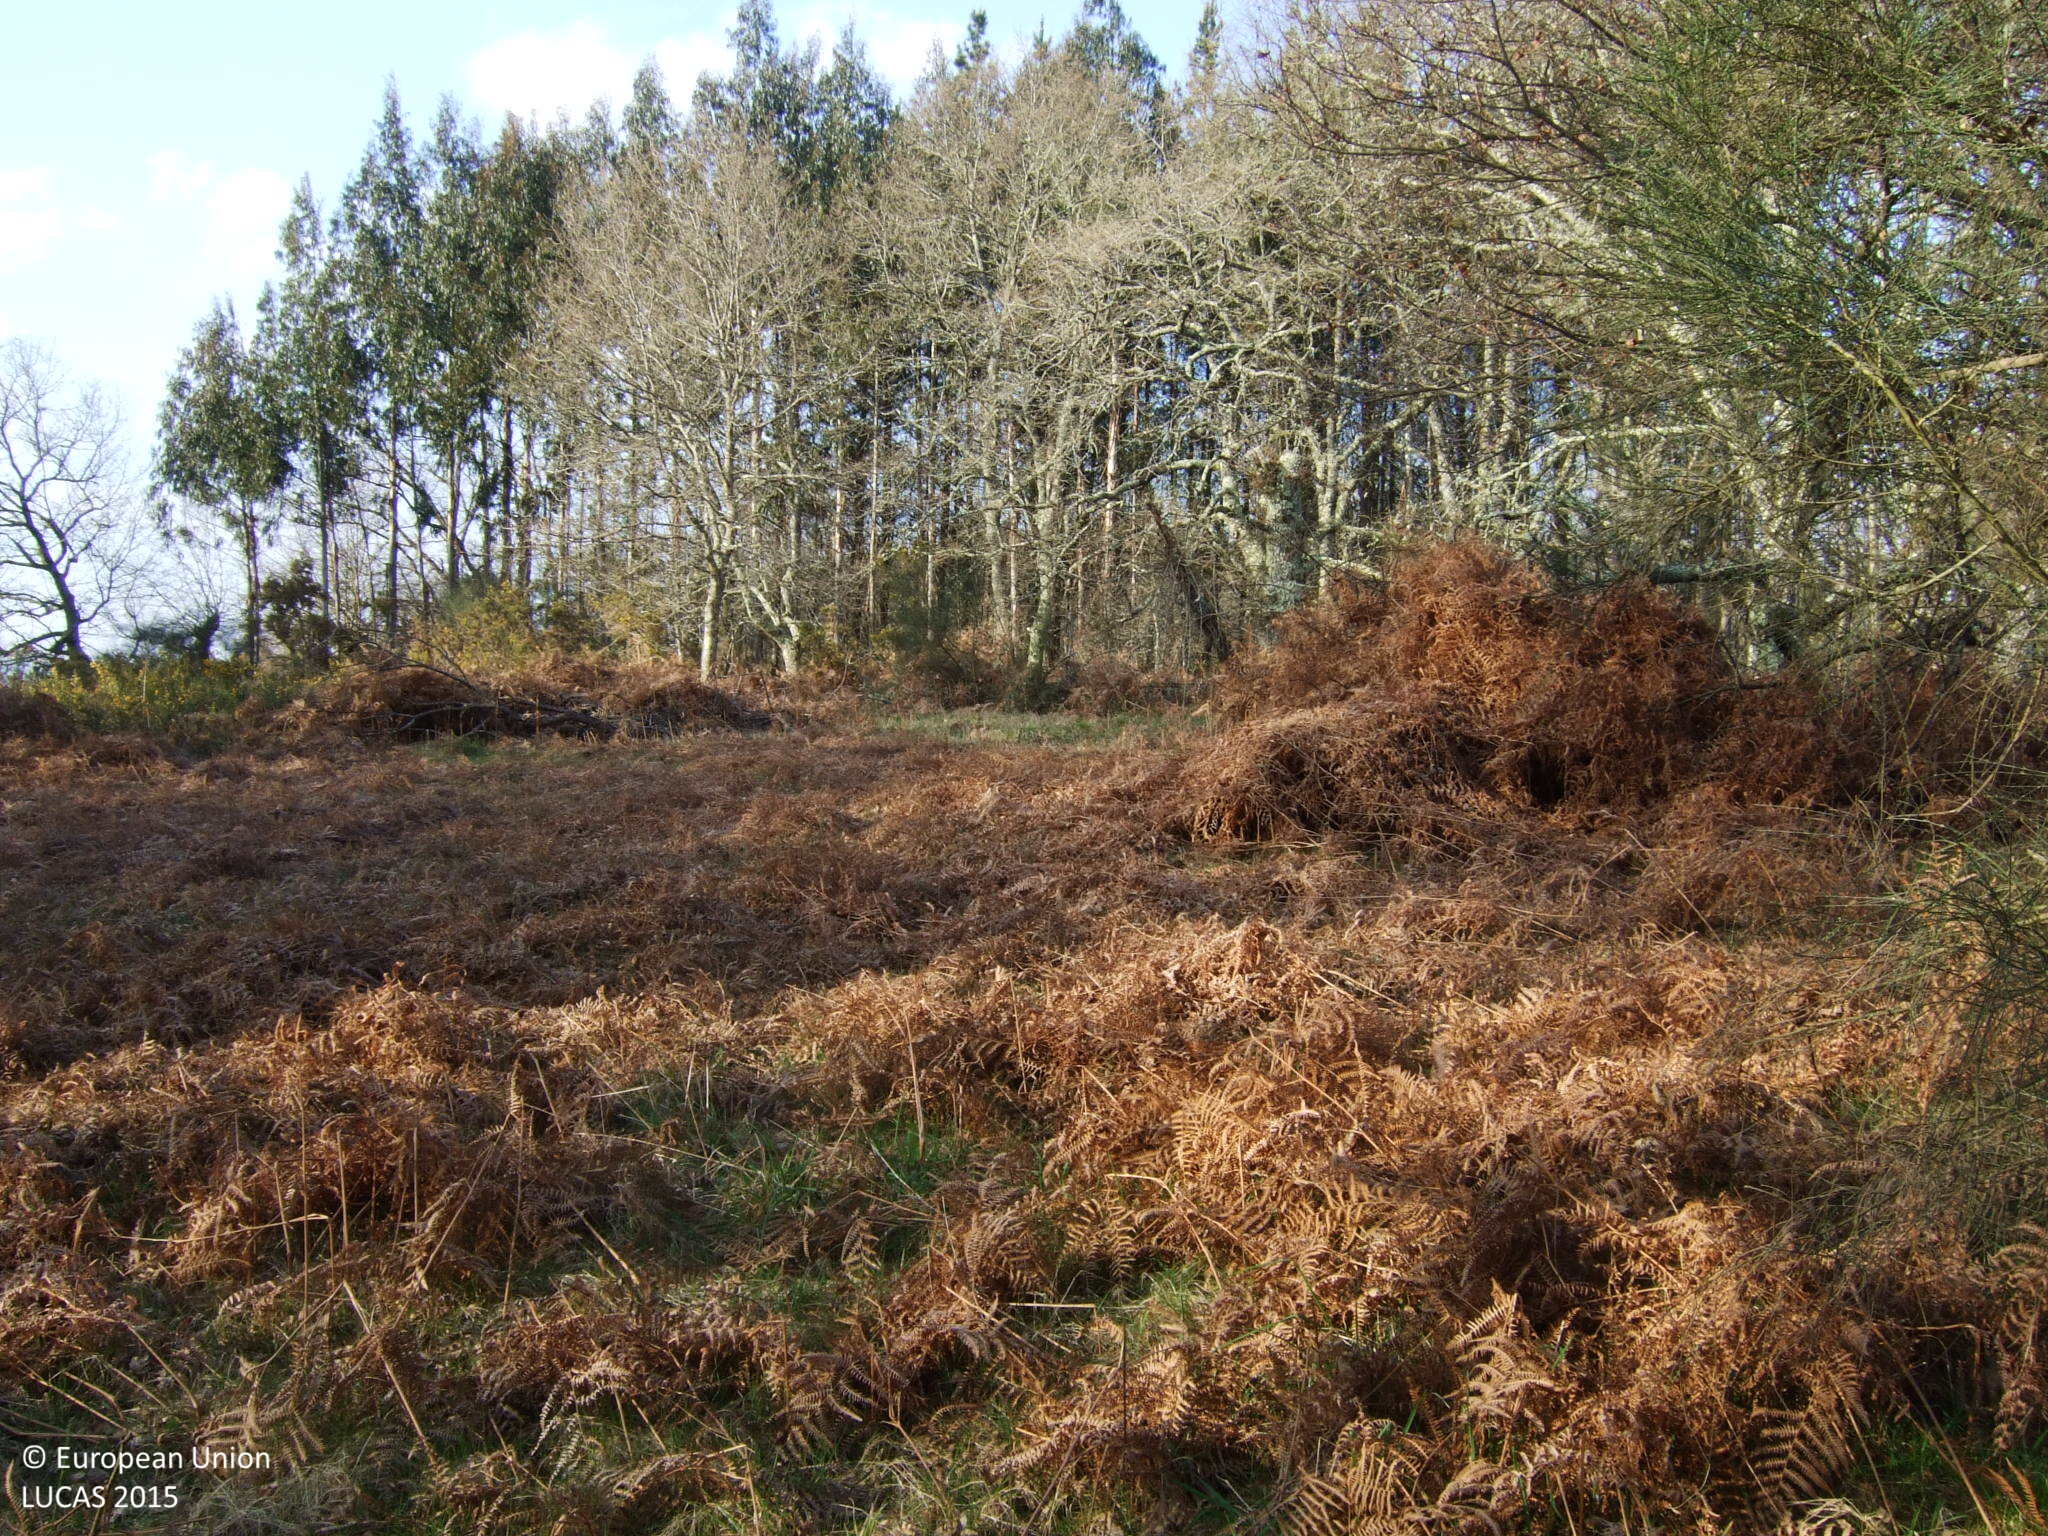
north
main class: Shrubland
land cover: Shrubland with sparse tree cover
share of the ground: > 75 %
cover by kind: shrubs 75 %, herbaceous plants 20 %, coniferous forest trees 5 %
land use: Abandoned areas
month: March
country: ES
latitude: 42.8539
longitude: -7.8907
